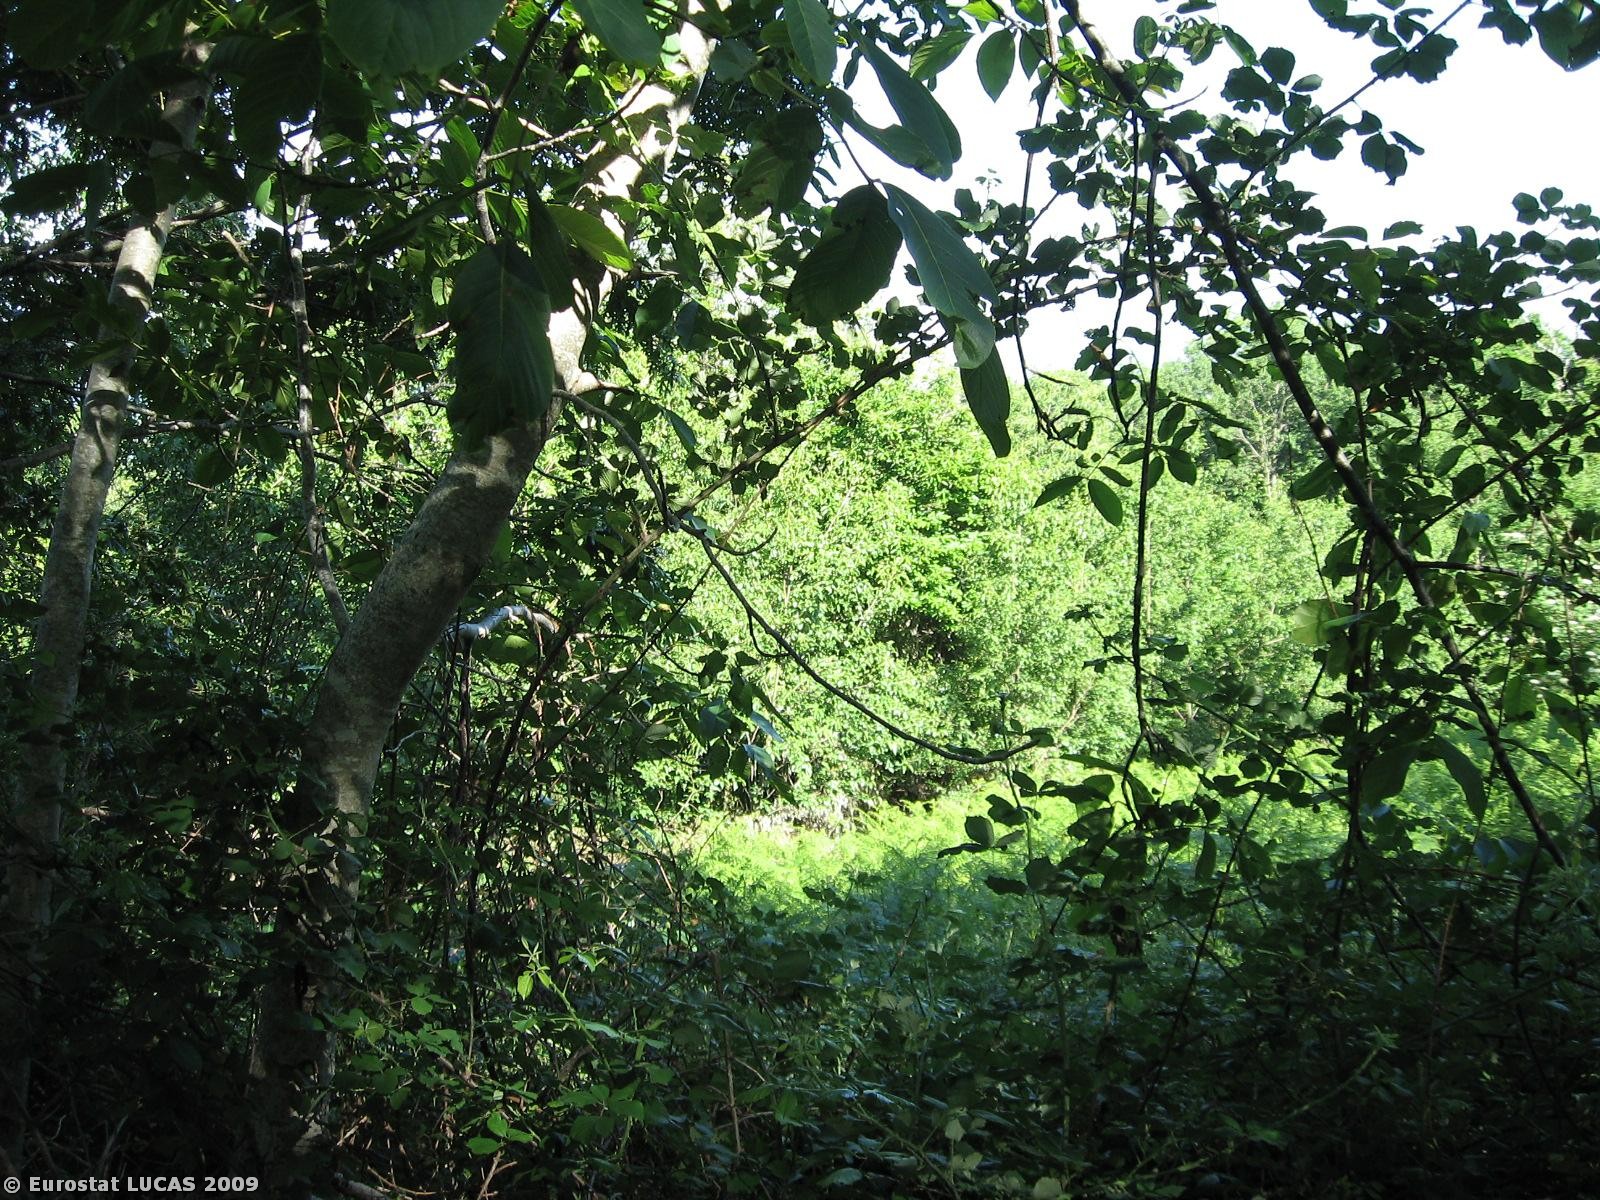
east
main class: Woodland
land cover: Broadleaved woodland
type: thermophilous deciduous forest
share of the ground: 50 - 75 %
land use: Forestry
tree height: > 5 m
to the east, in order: Broadleaved woodland; Grassland without tree/shrub cover; Tracks; Broadleaved woodland
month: June
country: IT
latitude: 39.0125
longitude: 16.2846
